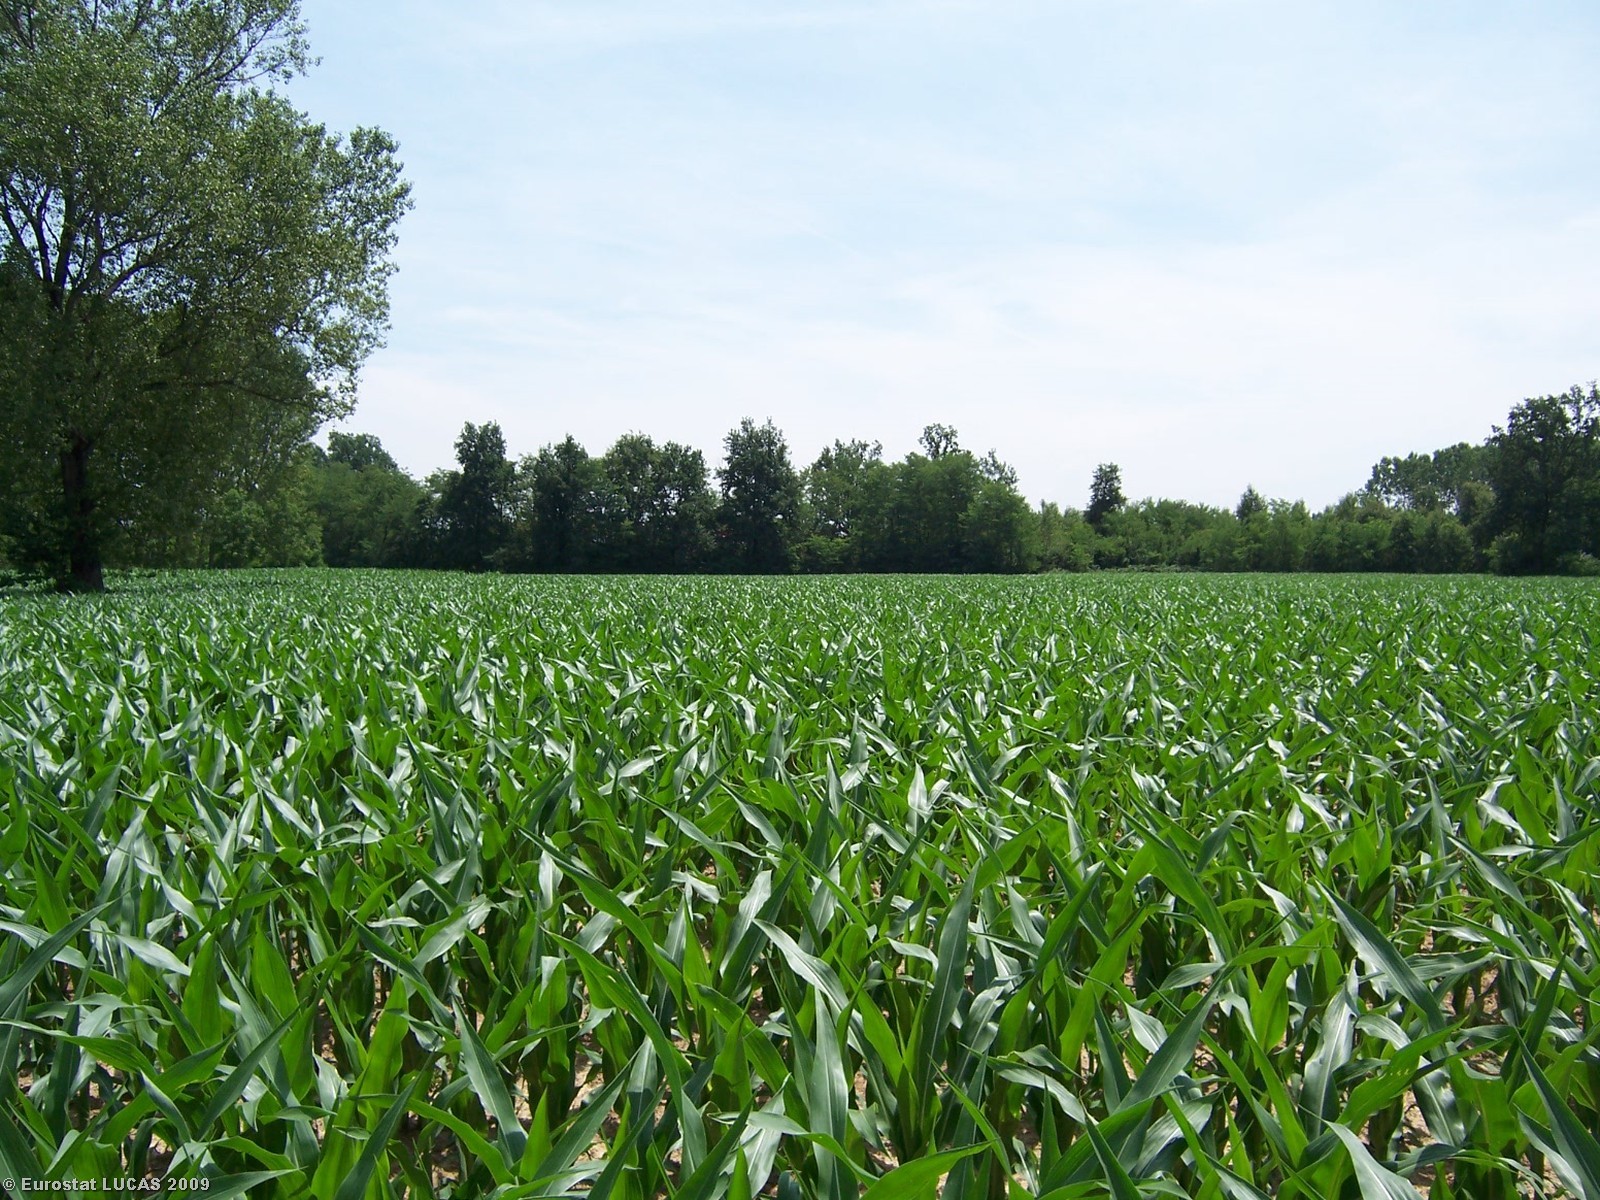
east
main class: Cropland
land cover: Maize
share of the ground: > 75 %
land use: Agriculture (excluding fallow land and kitchen gardens)
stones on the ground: < 10 %
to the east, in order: Maize; Abandoned hedges; Inland running water; Abandoned hedges; Other fruit trees and berries; Artificial constructions in urban areas; Other fresh vegetables
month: June
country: IT
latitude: 44.9496
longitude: 7.4063
